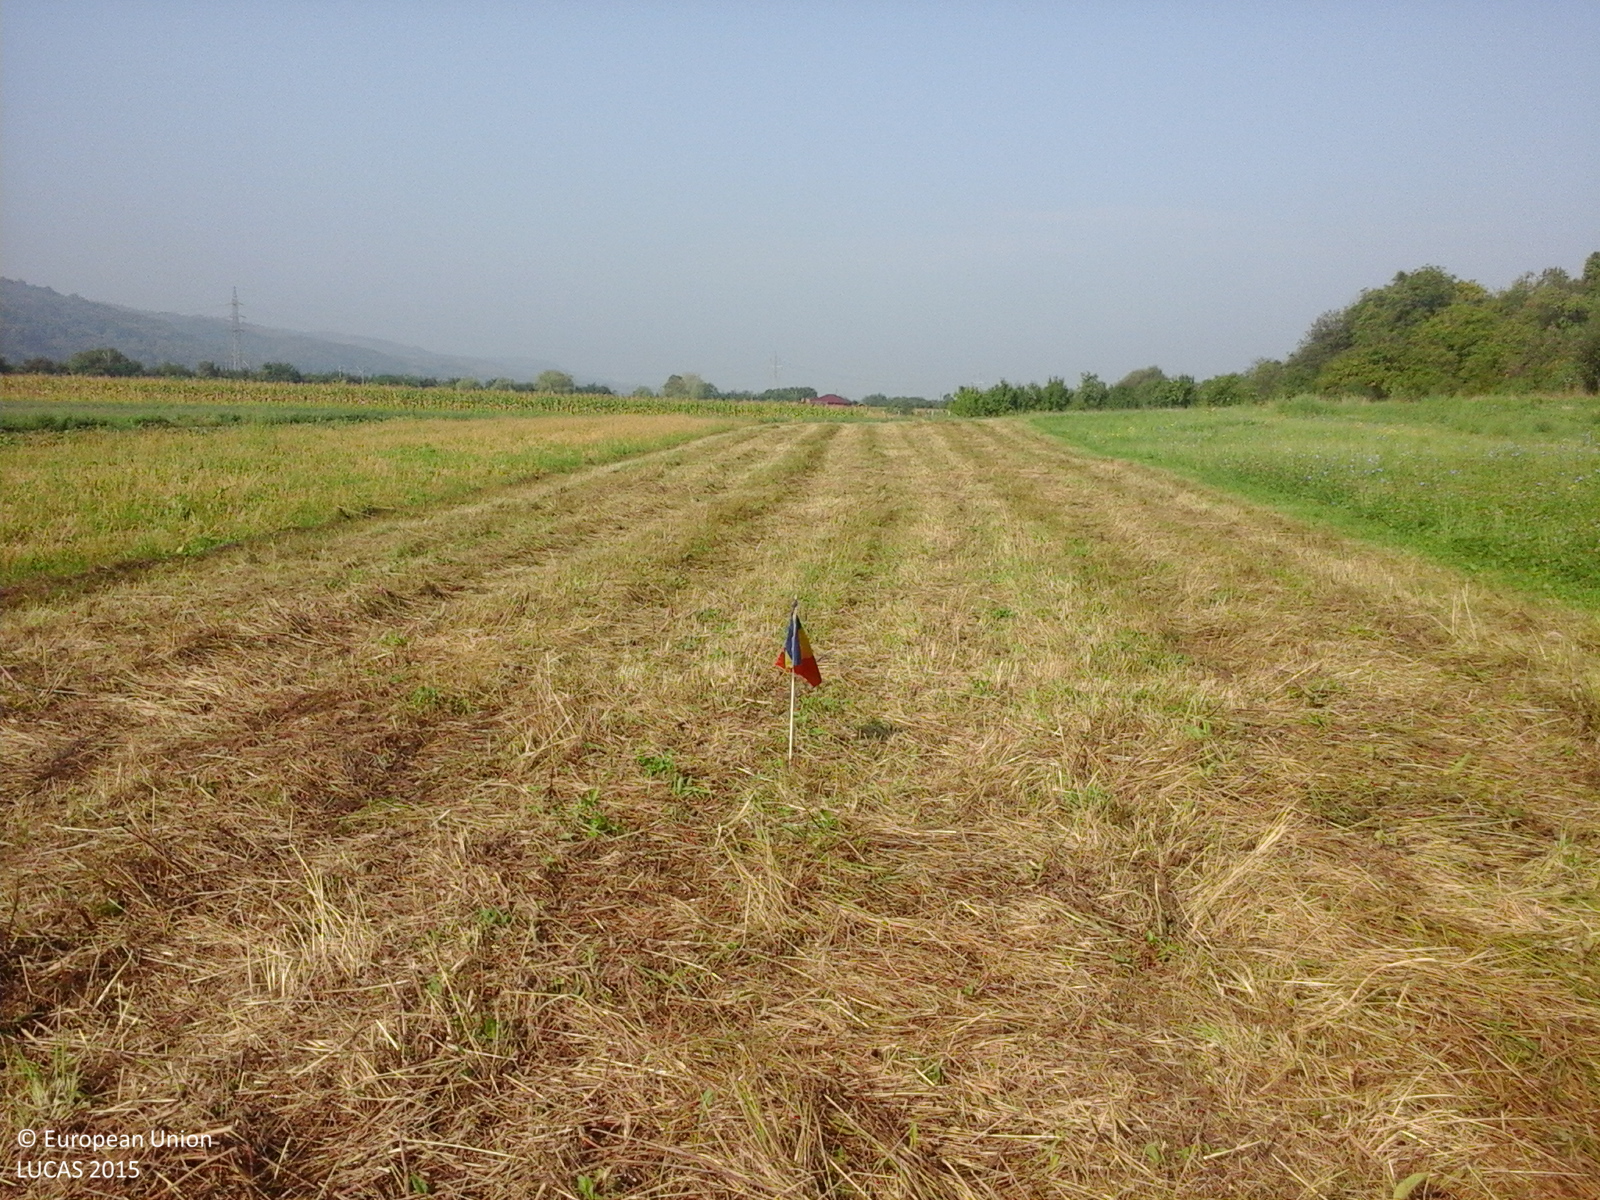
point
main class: Grassland
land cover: Grassland without tree/shrub cover
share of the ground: > 75 %
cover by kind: herbaceous plants 100 %
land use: Agriculture (excluding fallow land and kitchen gardens)
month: September
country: RO
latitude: 47.1789
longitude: 24.1368
